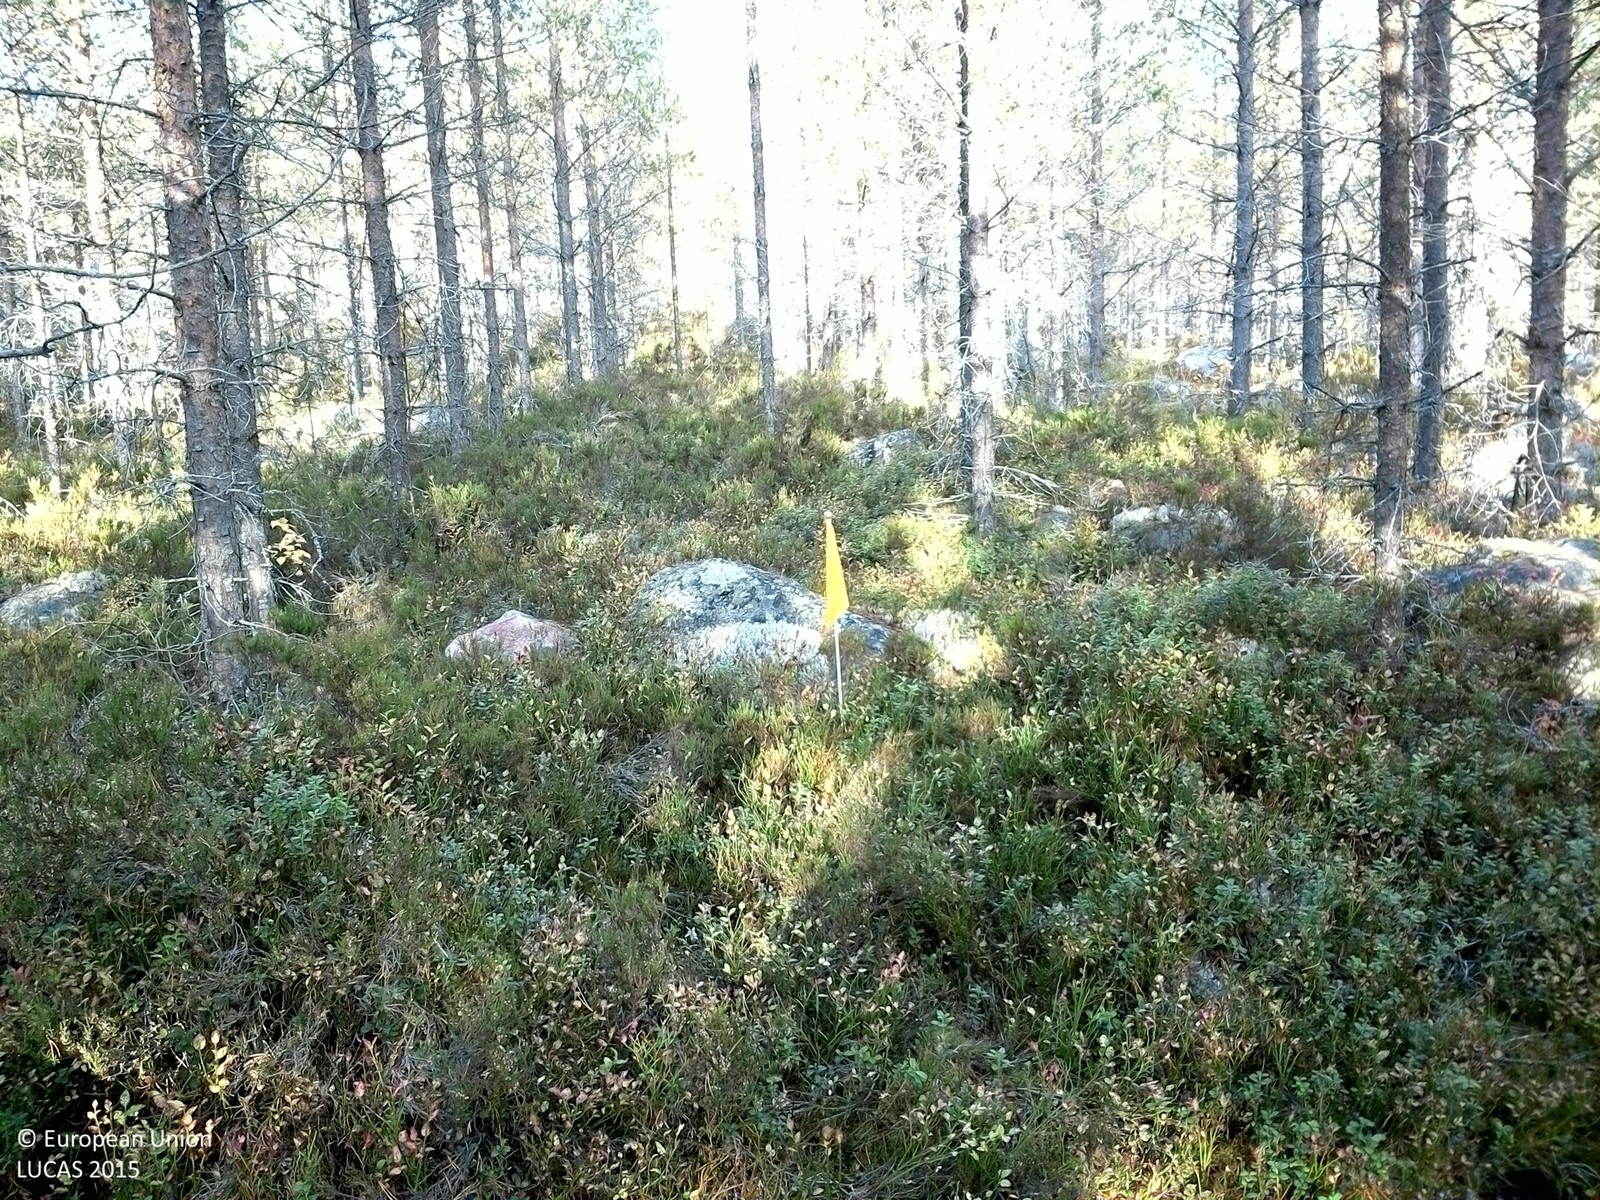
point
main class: Woodland
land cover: Pine dominated coniferous woodland
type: boreal forest
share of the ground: 50 - 75 %
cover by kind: coniferous forest trees 75 %, shrubs 15 %, lichens and mosses 5 %, consolidated bare surface 5 %
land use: Forestry
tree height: > 5 m
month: October
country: SE
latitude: 61.4421
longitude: 15.1037
